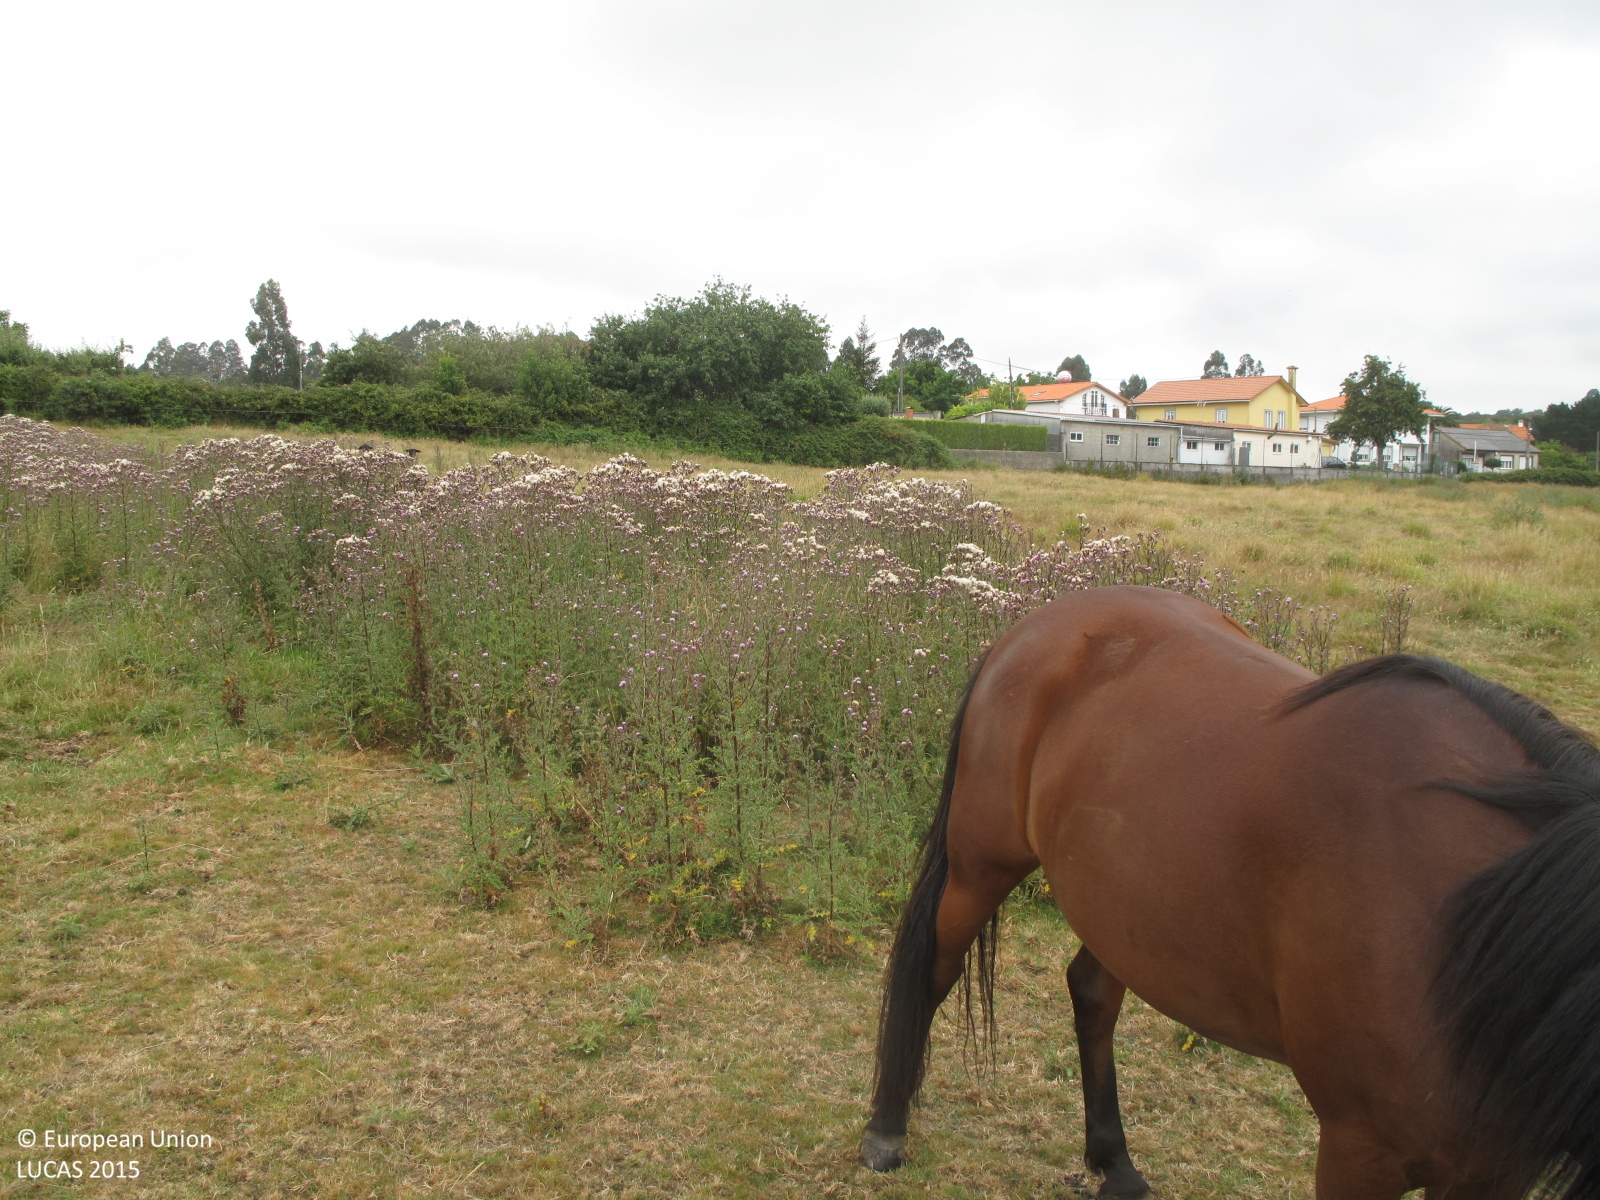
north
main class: Grassland
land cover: Grassland without tree/shrub cover
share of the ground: > 75 %
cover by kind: herbaceous plants 100 %
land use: Agriculture (excluding fallow land and kitchen gardens)
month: July
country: ES
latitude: 43.5394
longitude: -8.1828
